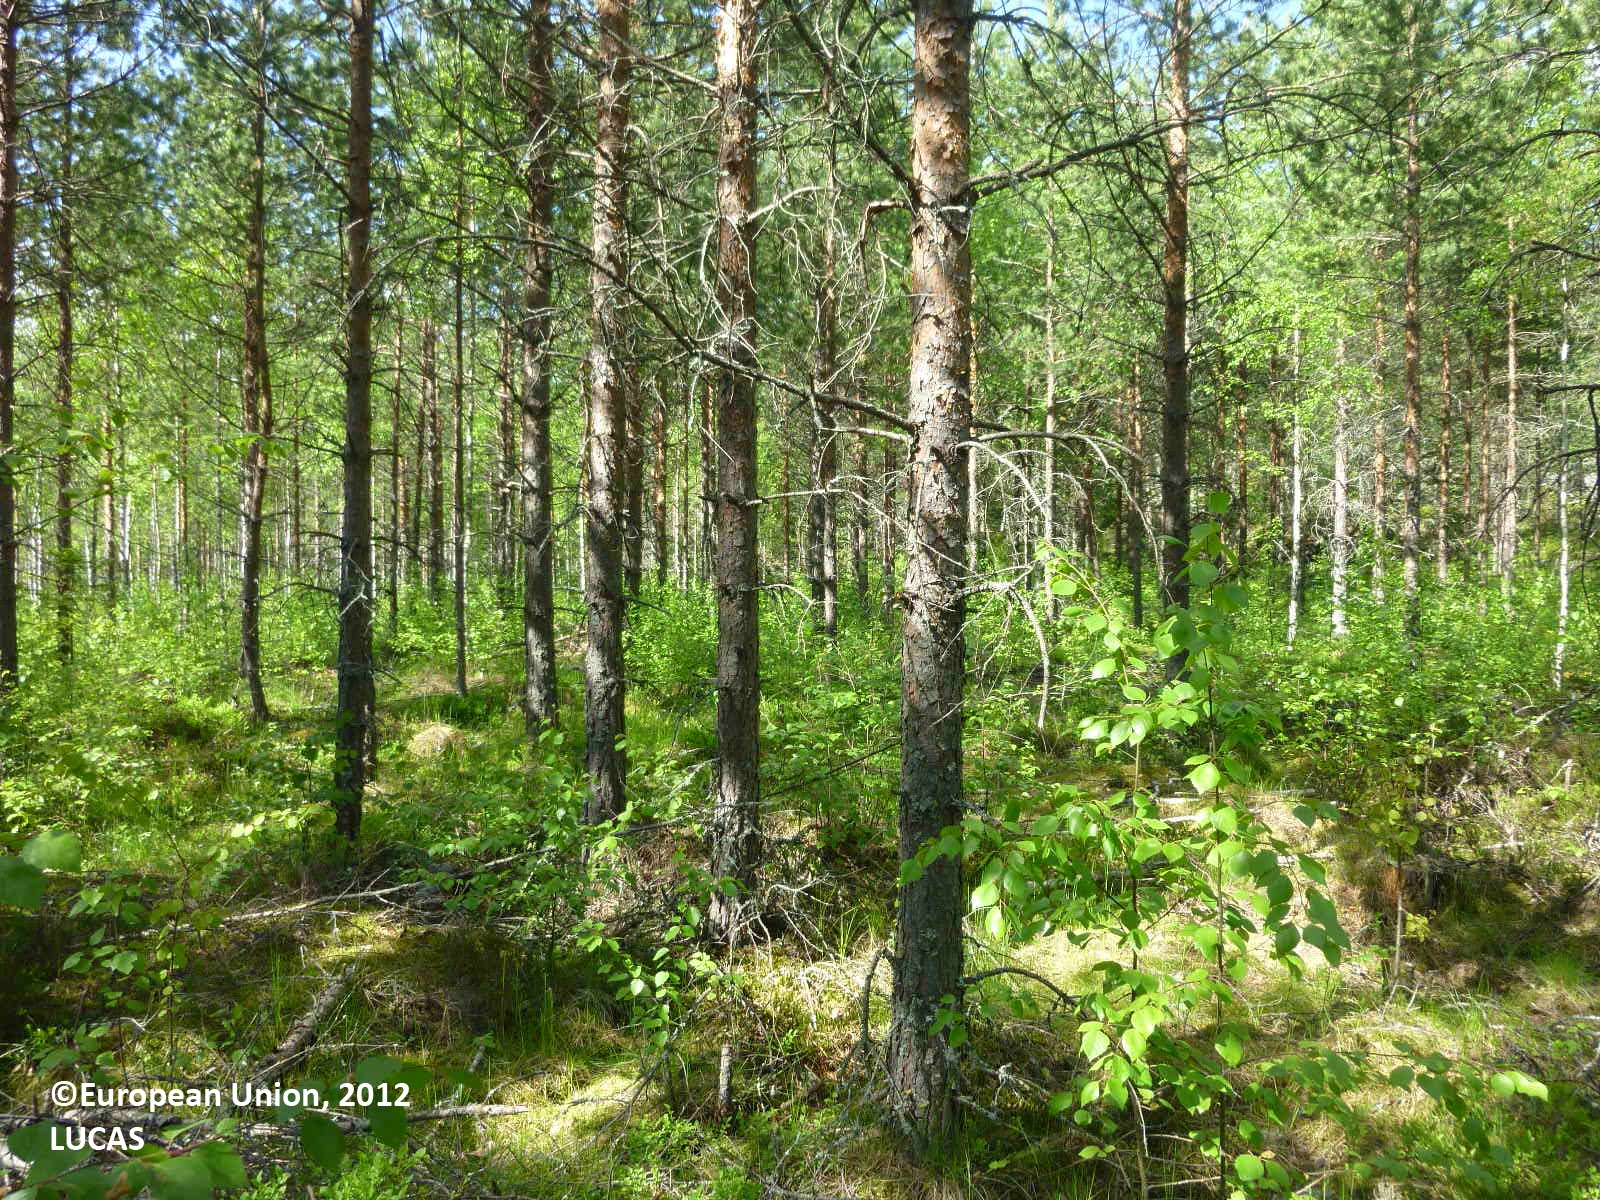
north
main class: Woodland
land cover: Pine dominated mixed woodland
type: boreal forest
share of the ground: 50 - 75 %
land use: Forestry
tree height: > 5 m
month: June
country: FI
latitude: 61.4442
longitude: 22.7637
